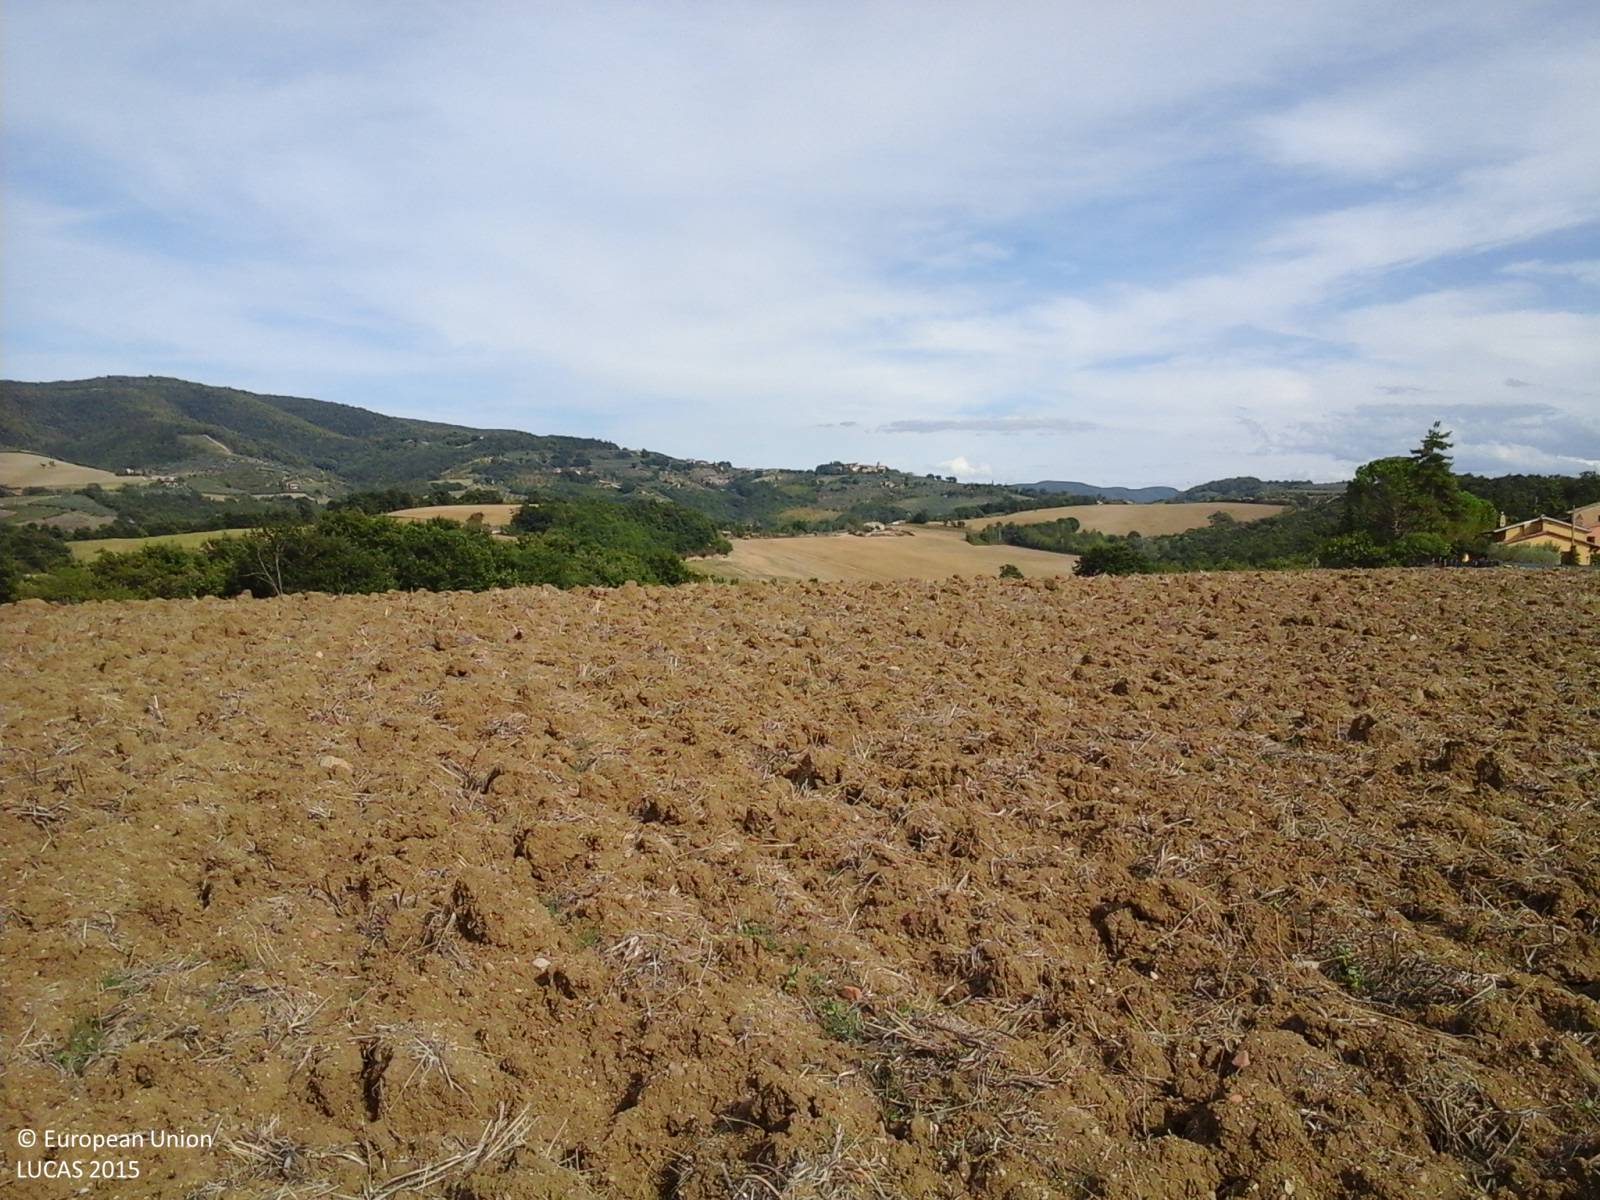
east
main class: Cropland
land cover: Dry pulses
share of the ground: < 10 %
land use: Agriculture (excluding fallow land and kitchen gardens)
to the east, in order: Dry pulses; Groves; Broadleaved woodland
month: September
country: IT
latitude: 42.9686
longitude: 12.4081
